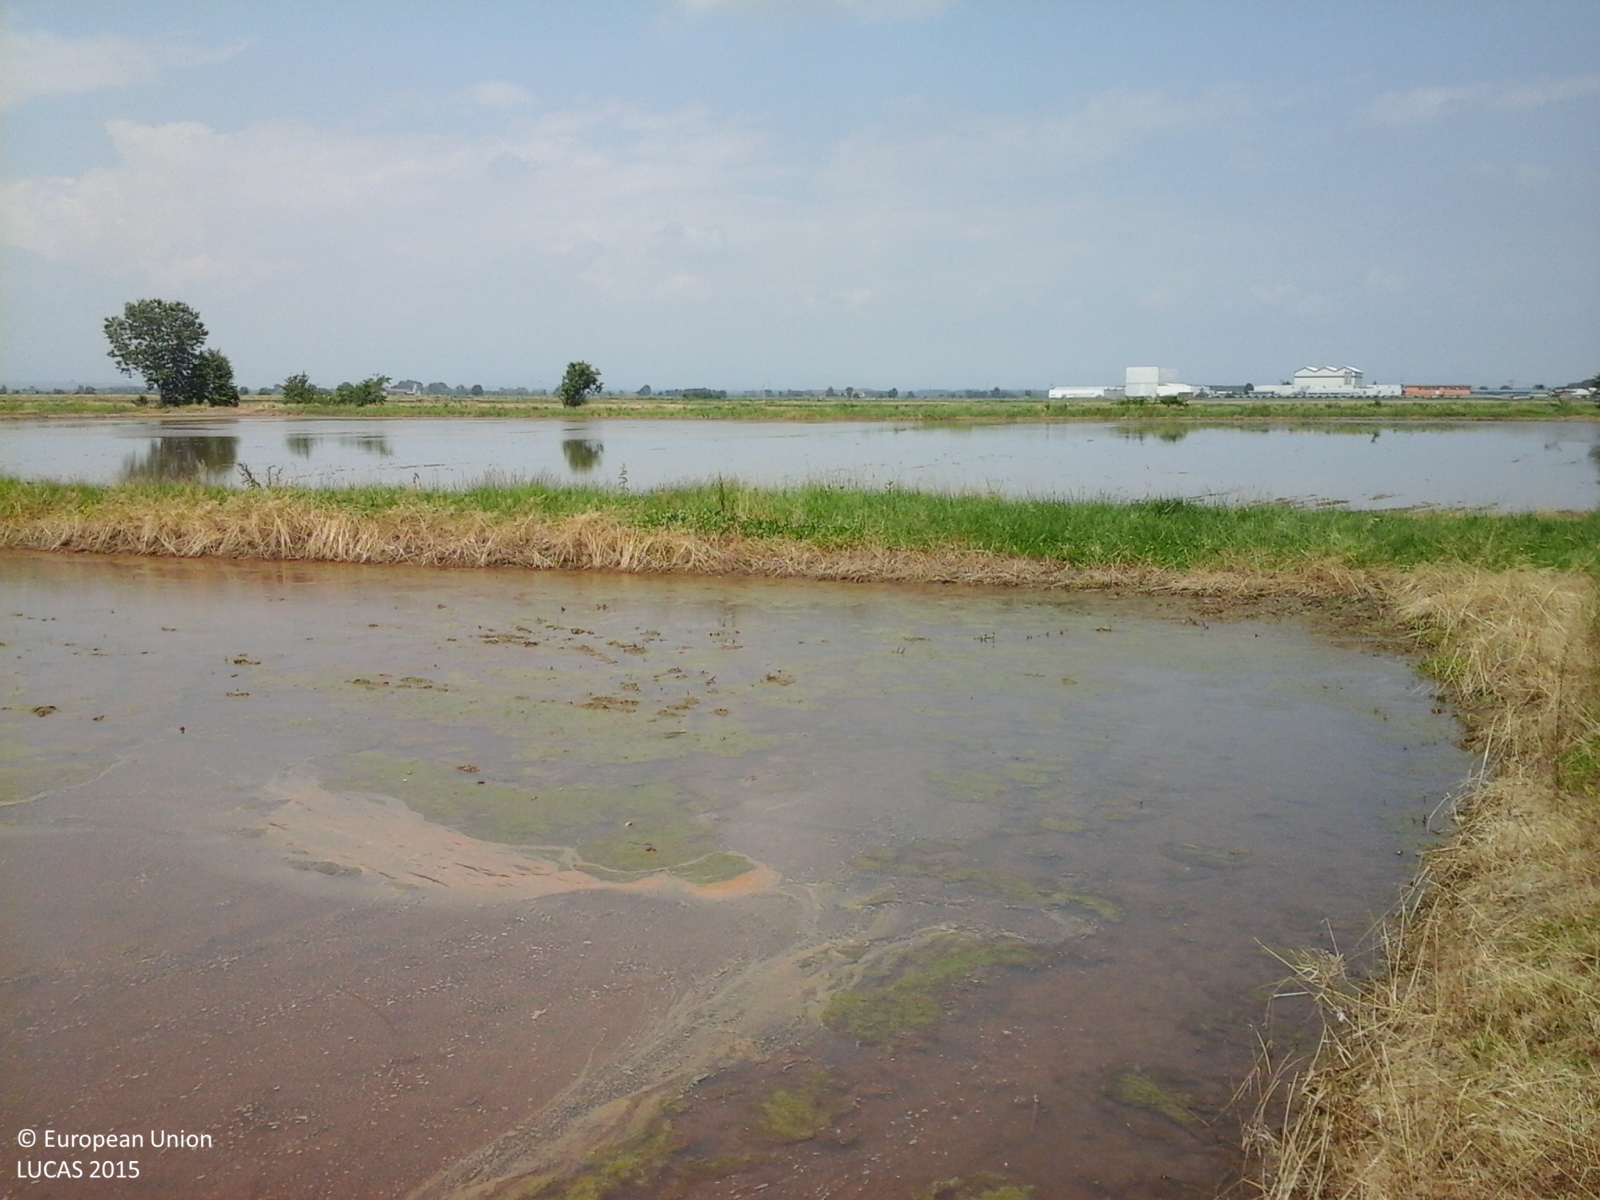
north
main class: Cropland
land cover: Rice
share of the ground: < 10 %
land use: Agriculture (excluding fallow land and kitchen gardens)
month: May
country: IT
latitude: 45.4183
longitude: 8.2777
